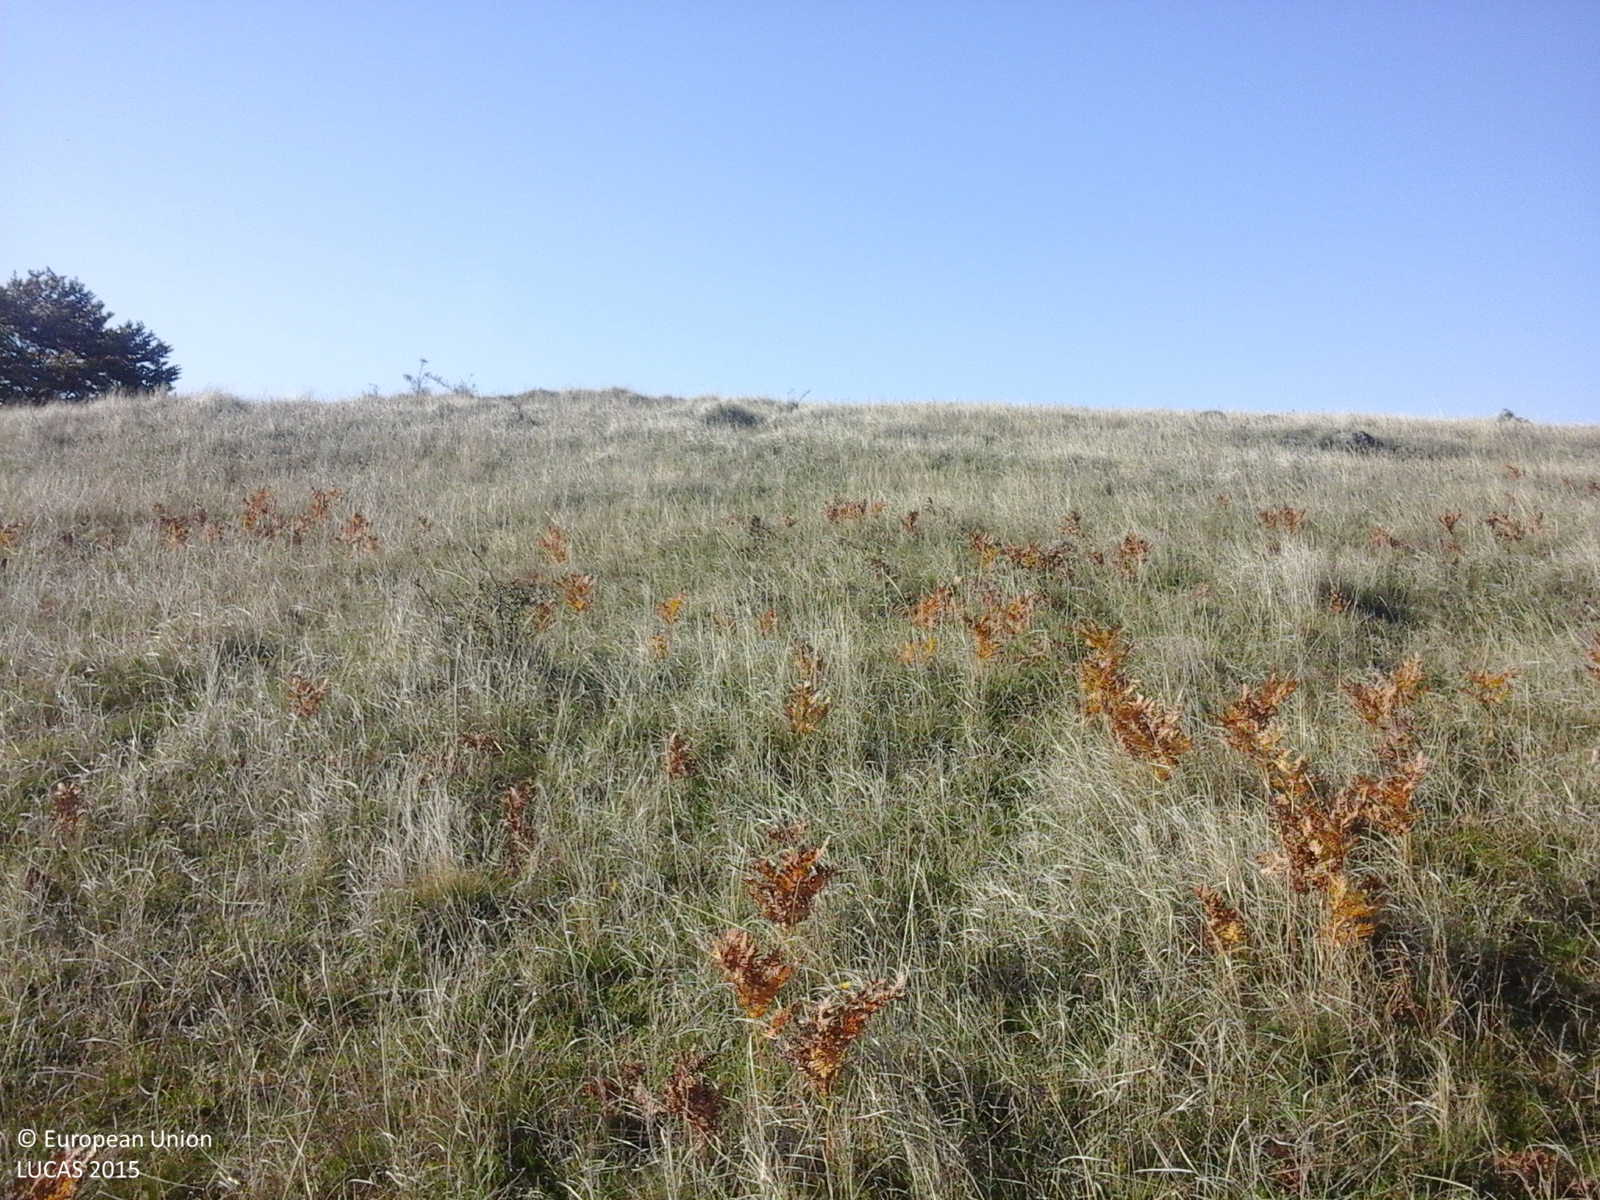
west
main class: Grassland
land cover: Grassland without tree/shrub cover
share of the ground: > 75 %
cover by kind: herbaceous plants 100 %
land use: Agriculture (excluding fallow land and kitchen gardens)
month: October
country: RO
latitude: 46.4314
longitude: 25.1841
